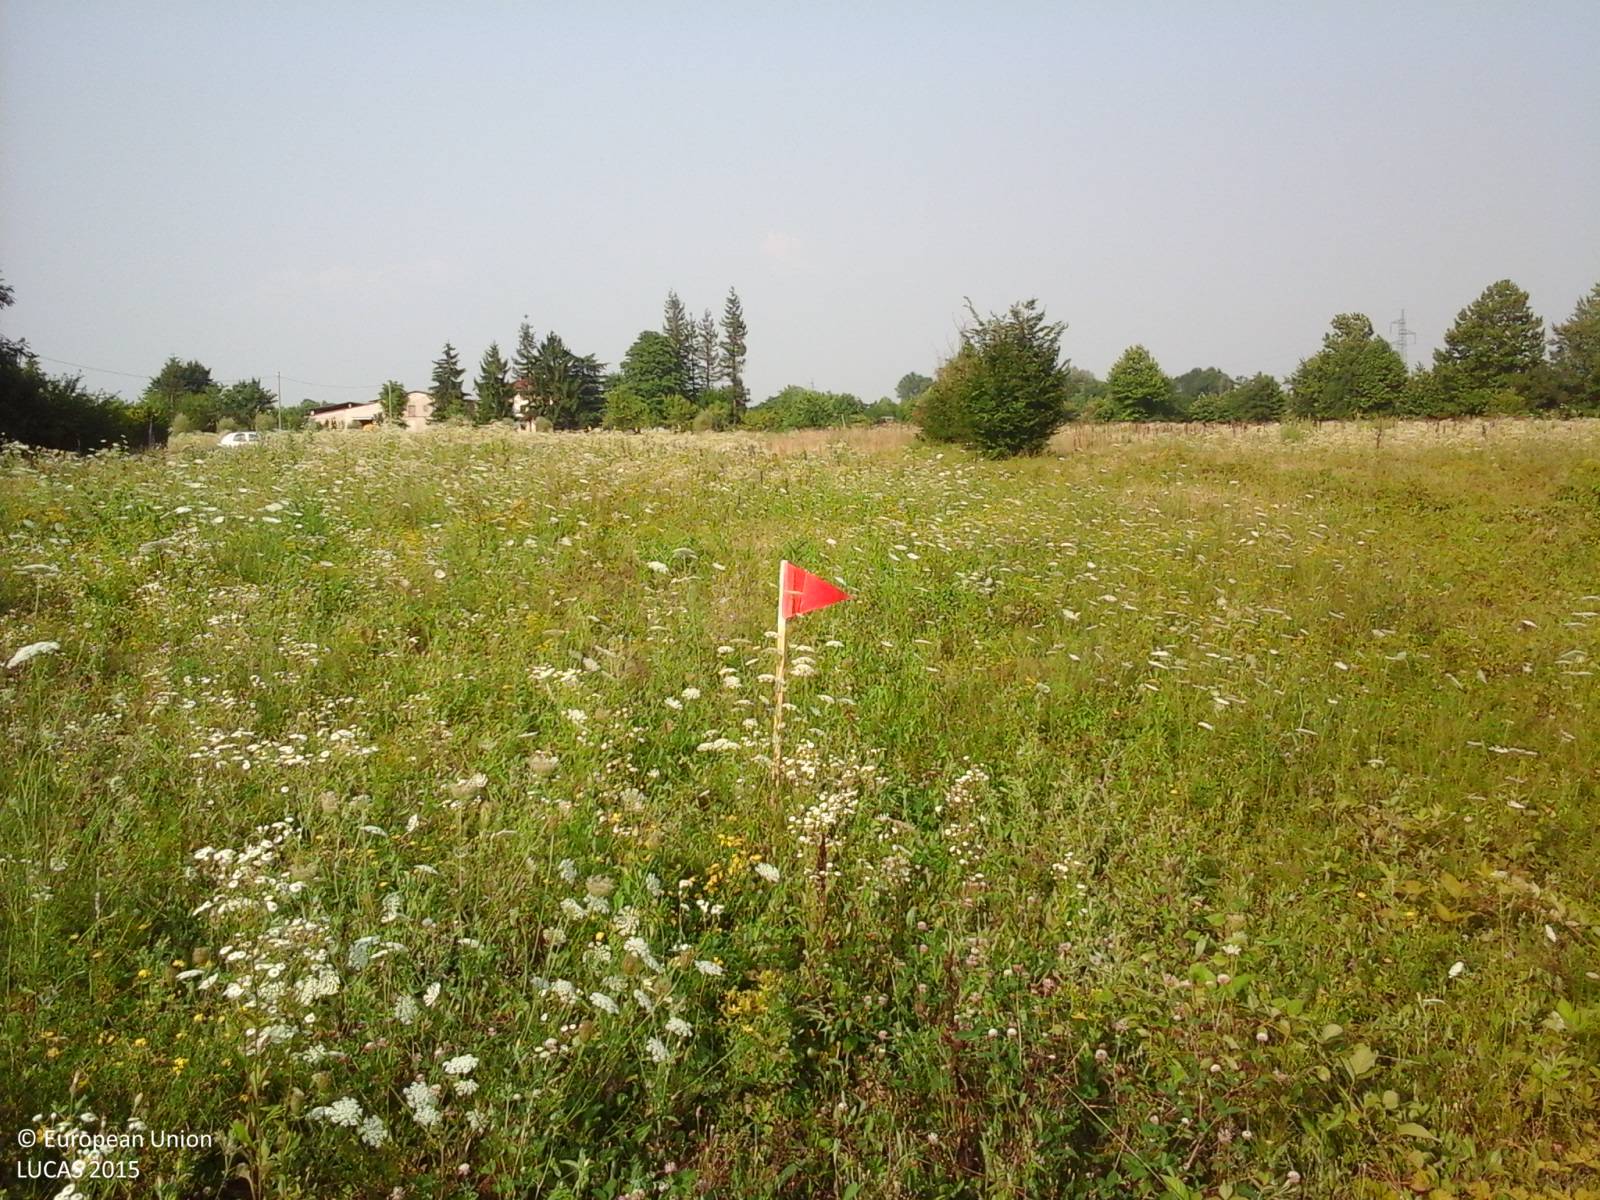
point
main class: Grassland
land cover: Spontaneously vegetated surfaces
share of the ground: > 75 %
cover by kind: herbaceous plants 100 %
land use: Fallow land
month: July
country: IT
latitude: 45.9022
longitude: 12.7162
